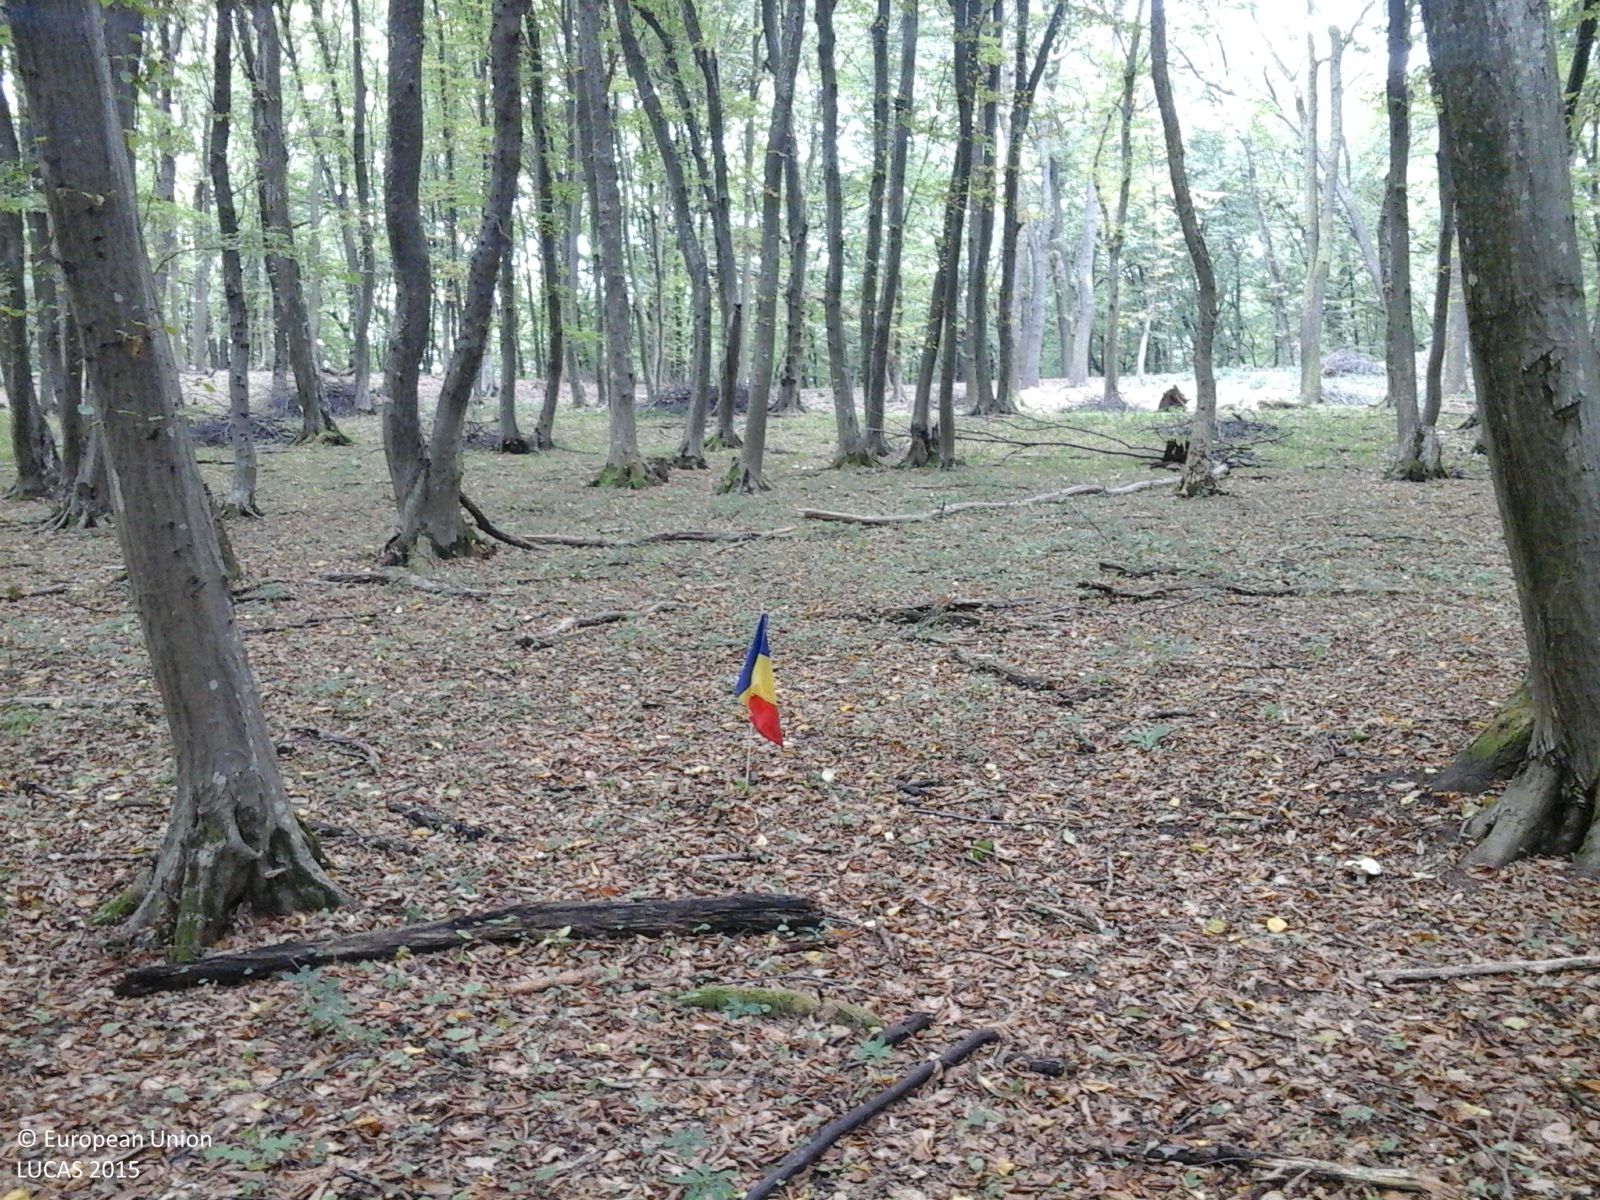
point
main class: Woodland
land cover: Broadleaved woodland
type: mesophytic deciduous forest
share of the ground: > 75 %
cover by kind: broadleaved forest trees 100 %
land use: Forestry
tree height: > 5 m
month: October
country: RO
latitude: 46.2568
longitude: 24.7360
